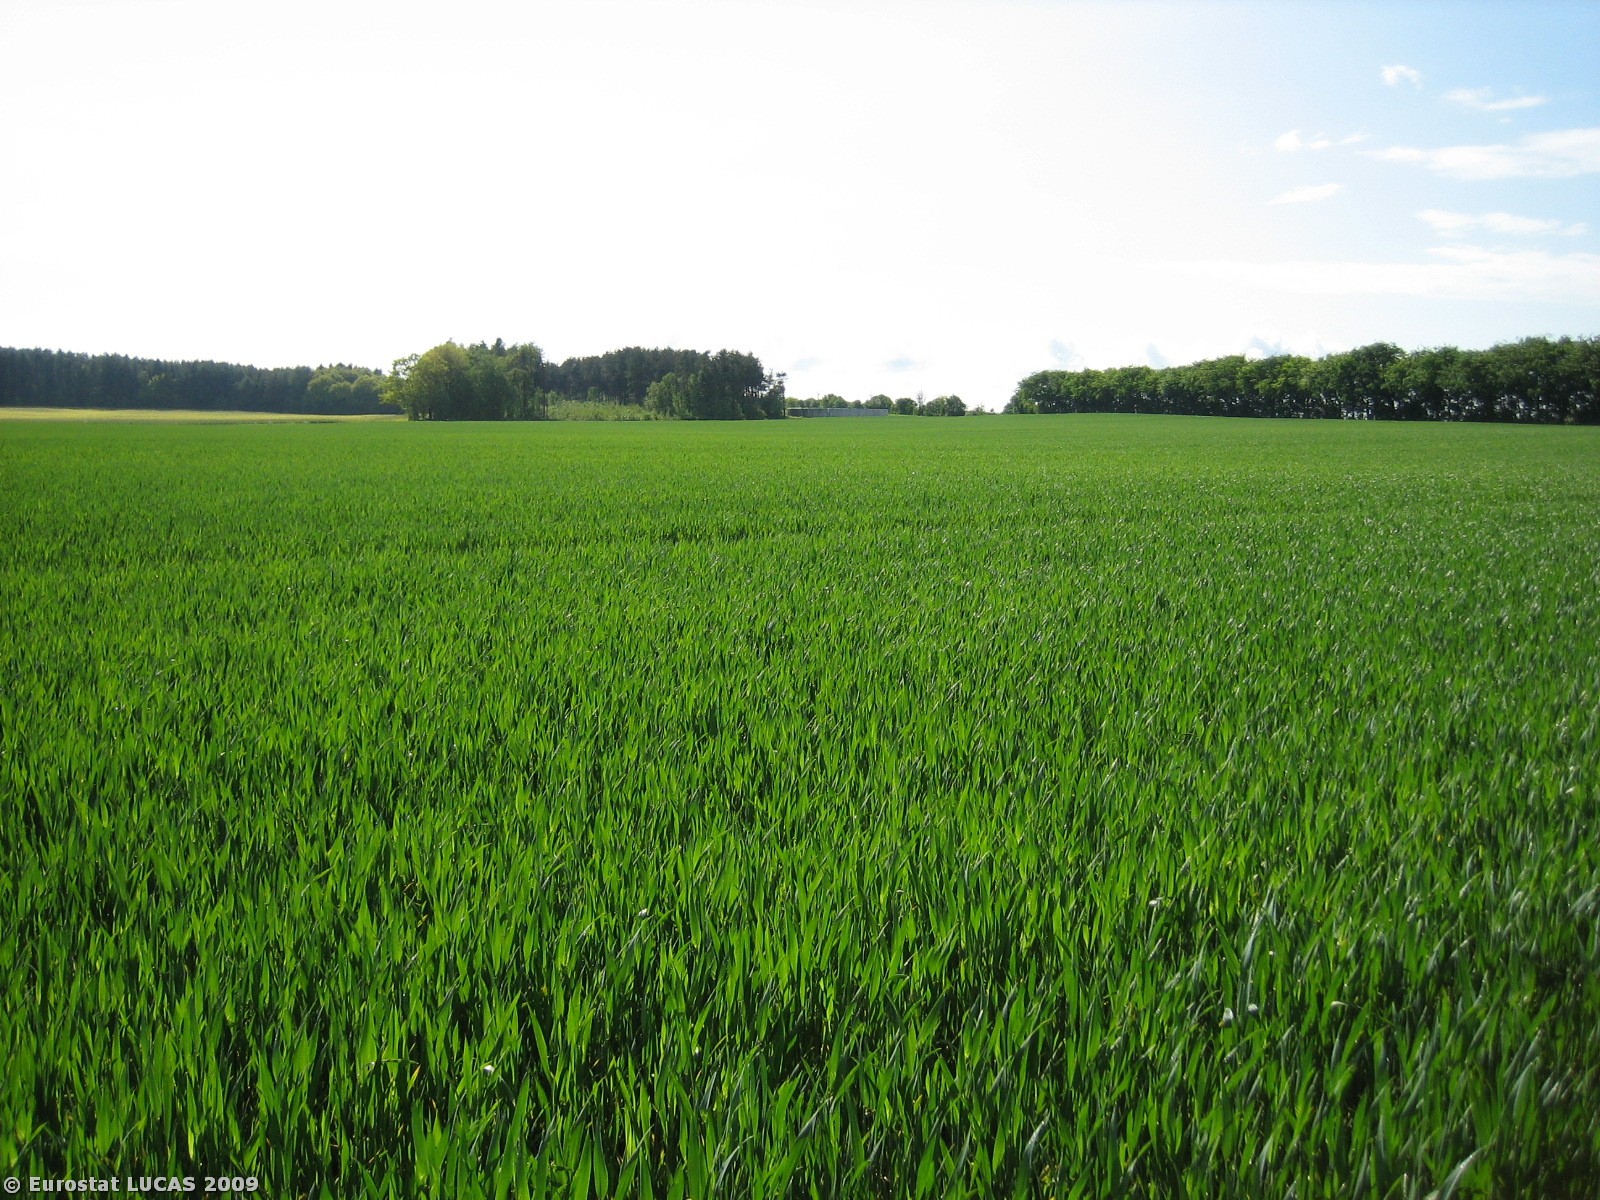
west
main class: Woodland
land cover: Broadleaved woodland
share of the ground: > 75 %
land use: Forestry
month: May
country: DK
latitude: 56.1638
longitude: 8.7615
